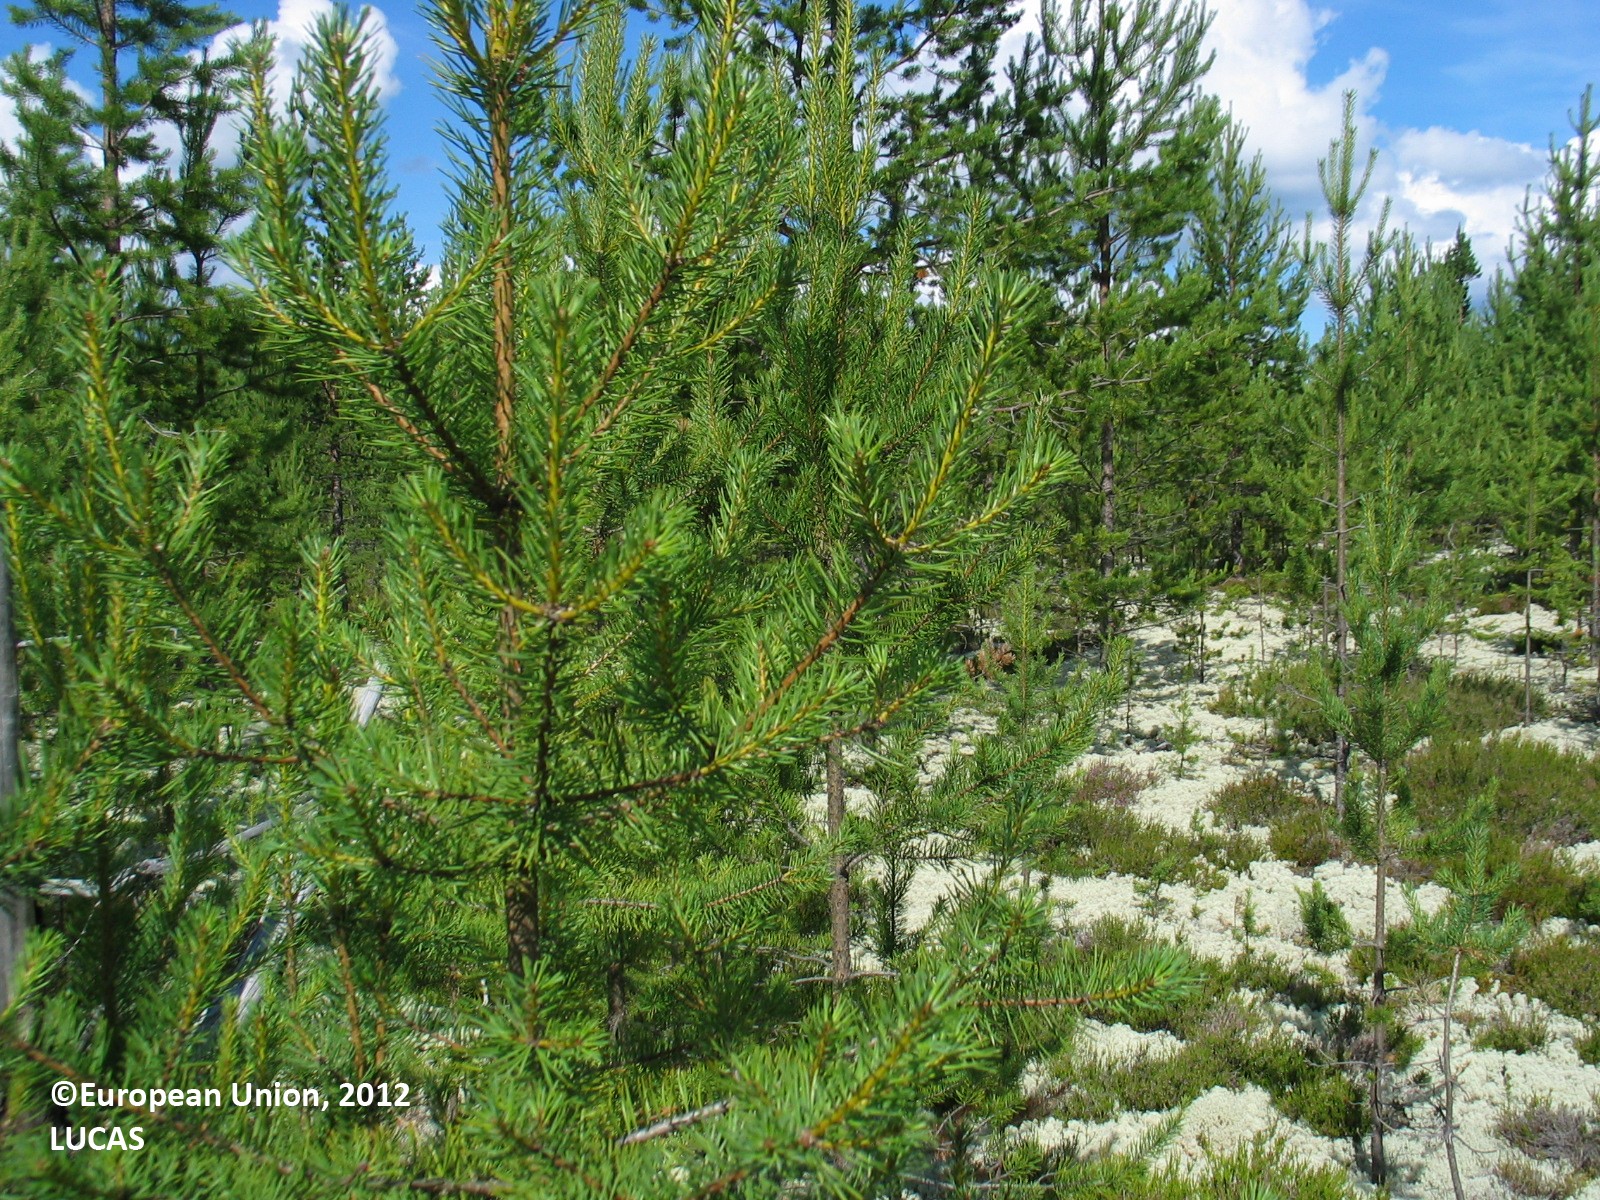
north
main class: Woodland
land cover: Pine dominated coniferous woodland
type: boreal forest
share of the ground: 25 - 50 %
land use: Forestry
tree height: > 5 m
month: July
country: FI
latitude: 64.6077
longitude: 26.4350
